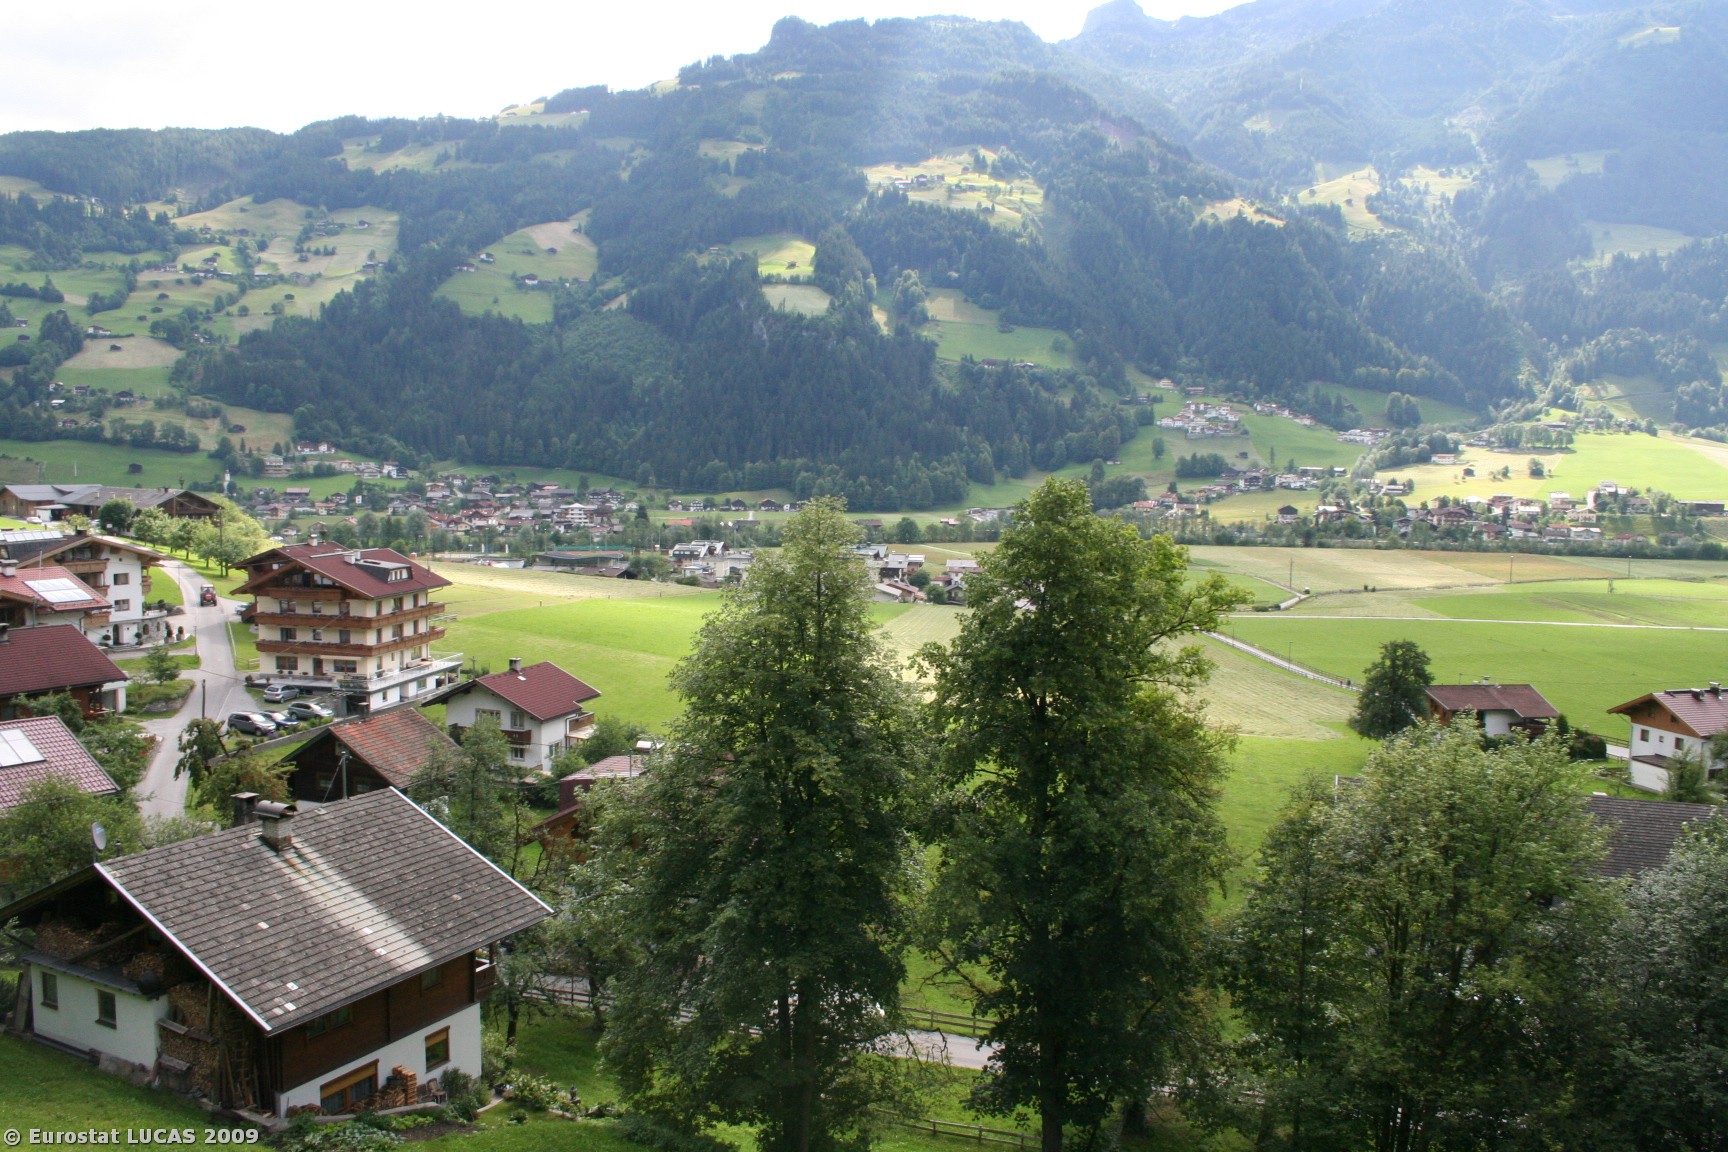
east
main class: Grassland
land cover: Grassland without tree/shrub cover
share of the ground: > 75 %
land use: Agriculture (excluding fallow land and kitchen gardens)
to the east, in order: Grassland without tree/shrub cover; Tracks; Broadleaved woodland; Grassland with sparse tree/shrub cover; Fences; Grassland without tree/shrub cover; Paved roads, cycling and walking lanes; Artificial constructions in urban areas; Grassland without tree/shrub cover
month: June
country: AT
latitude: 47.1996
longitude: 11.8596
